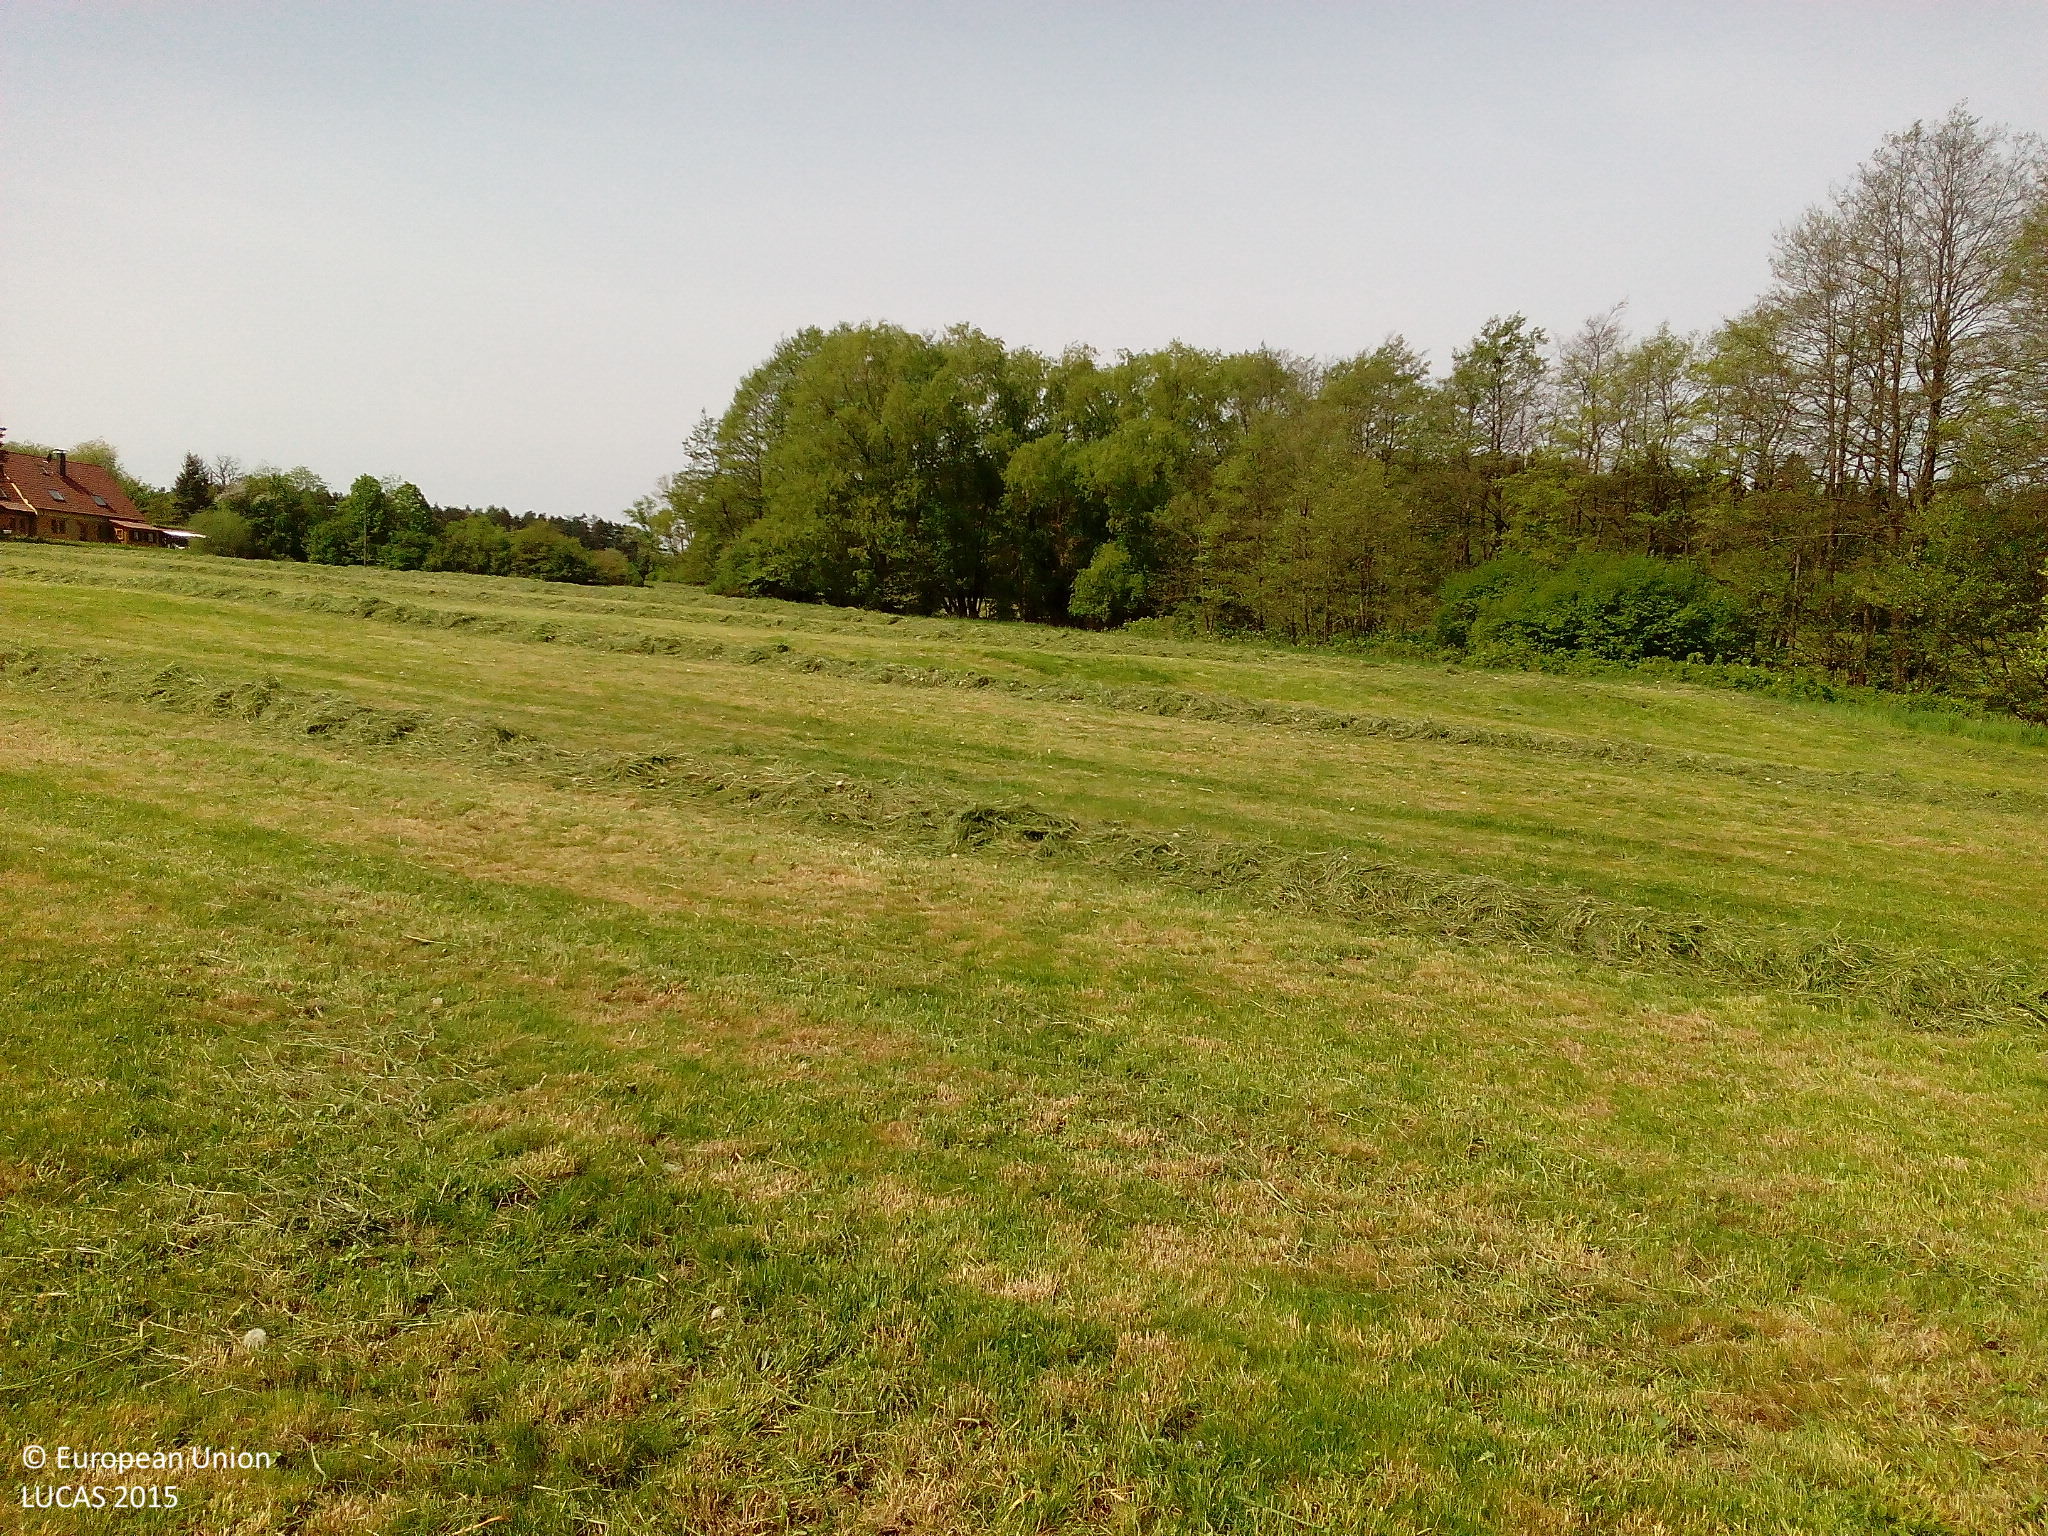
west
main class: Grassland
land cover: Grassland without tree/shrub cover
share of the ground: > 75 %
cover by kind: herbaceous plants 100 %
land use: Agriculture (excluding fallow land and kitchen gardens)
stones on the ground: < 10 %
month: May
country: DE
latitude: 49.9410
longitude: 11.4627
